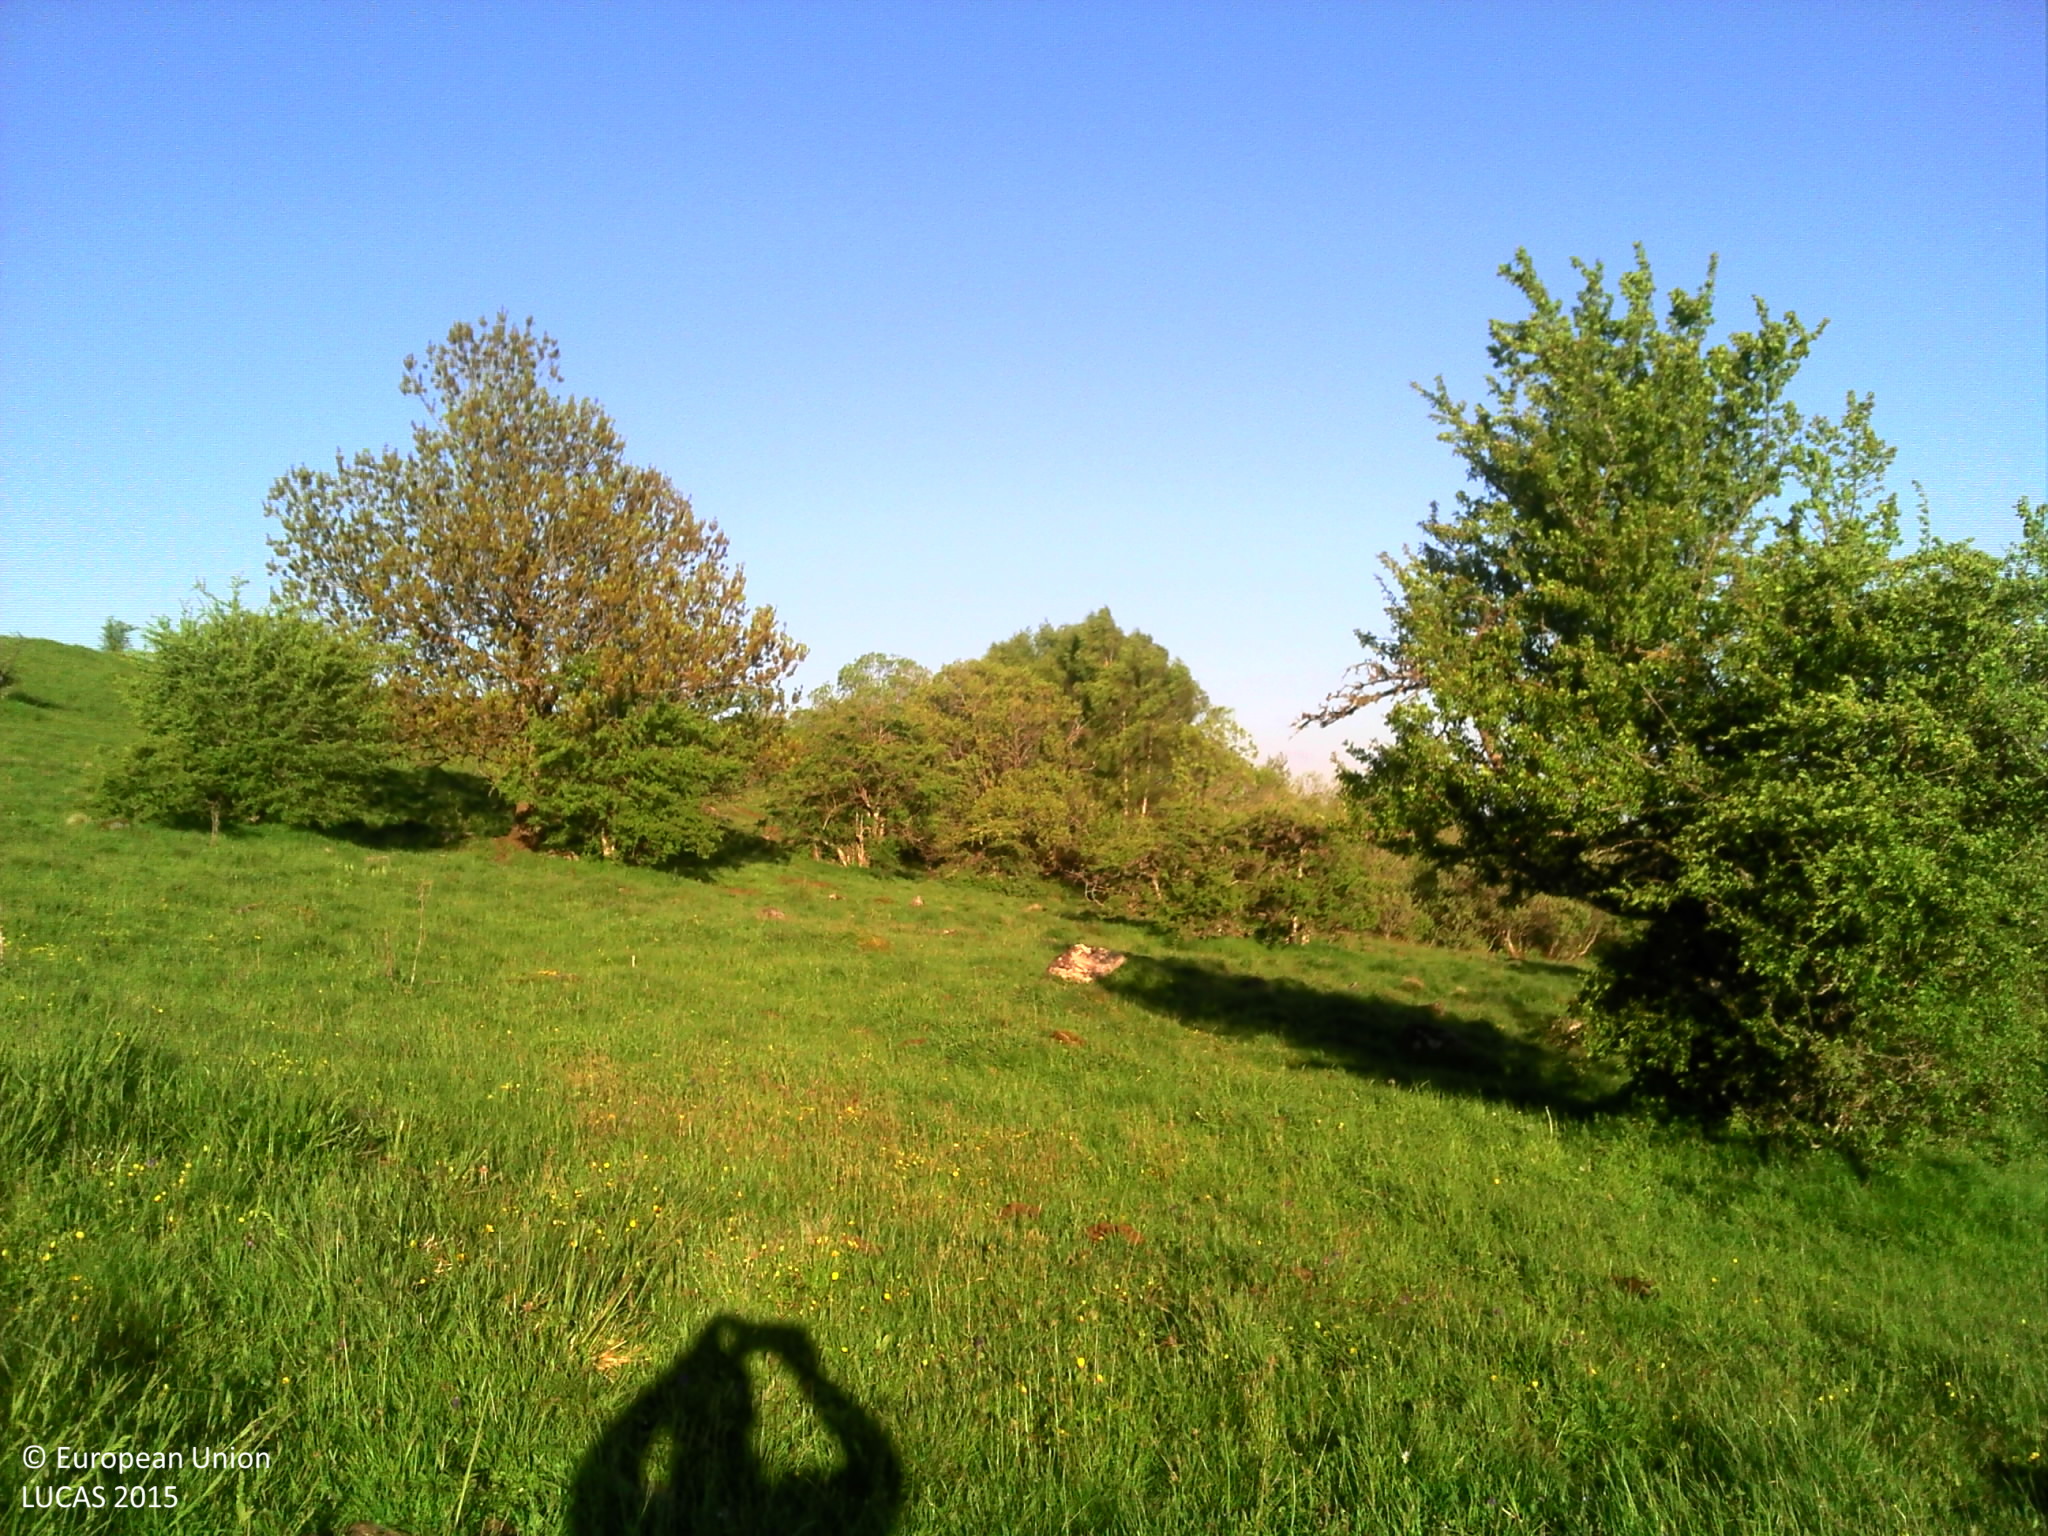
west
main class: Grassland
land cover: Grassland without tree/shrub cover
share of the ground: > 75 %
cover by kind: herbaceous plants 100 %
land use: Agriculture (excluding fallow land and kitchen gardens)
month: May
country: FR
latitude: 45.3533
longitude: 2.8650
